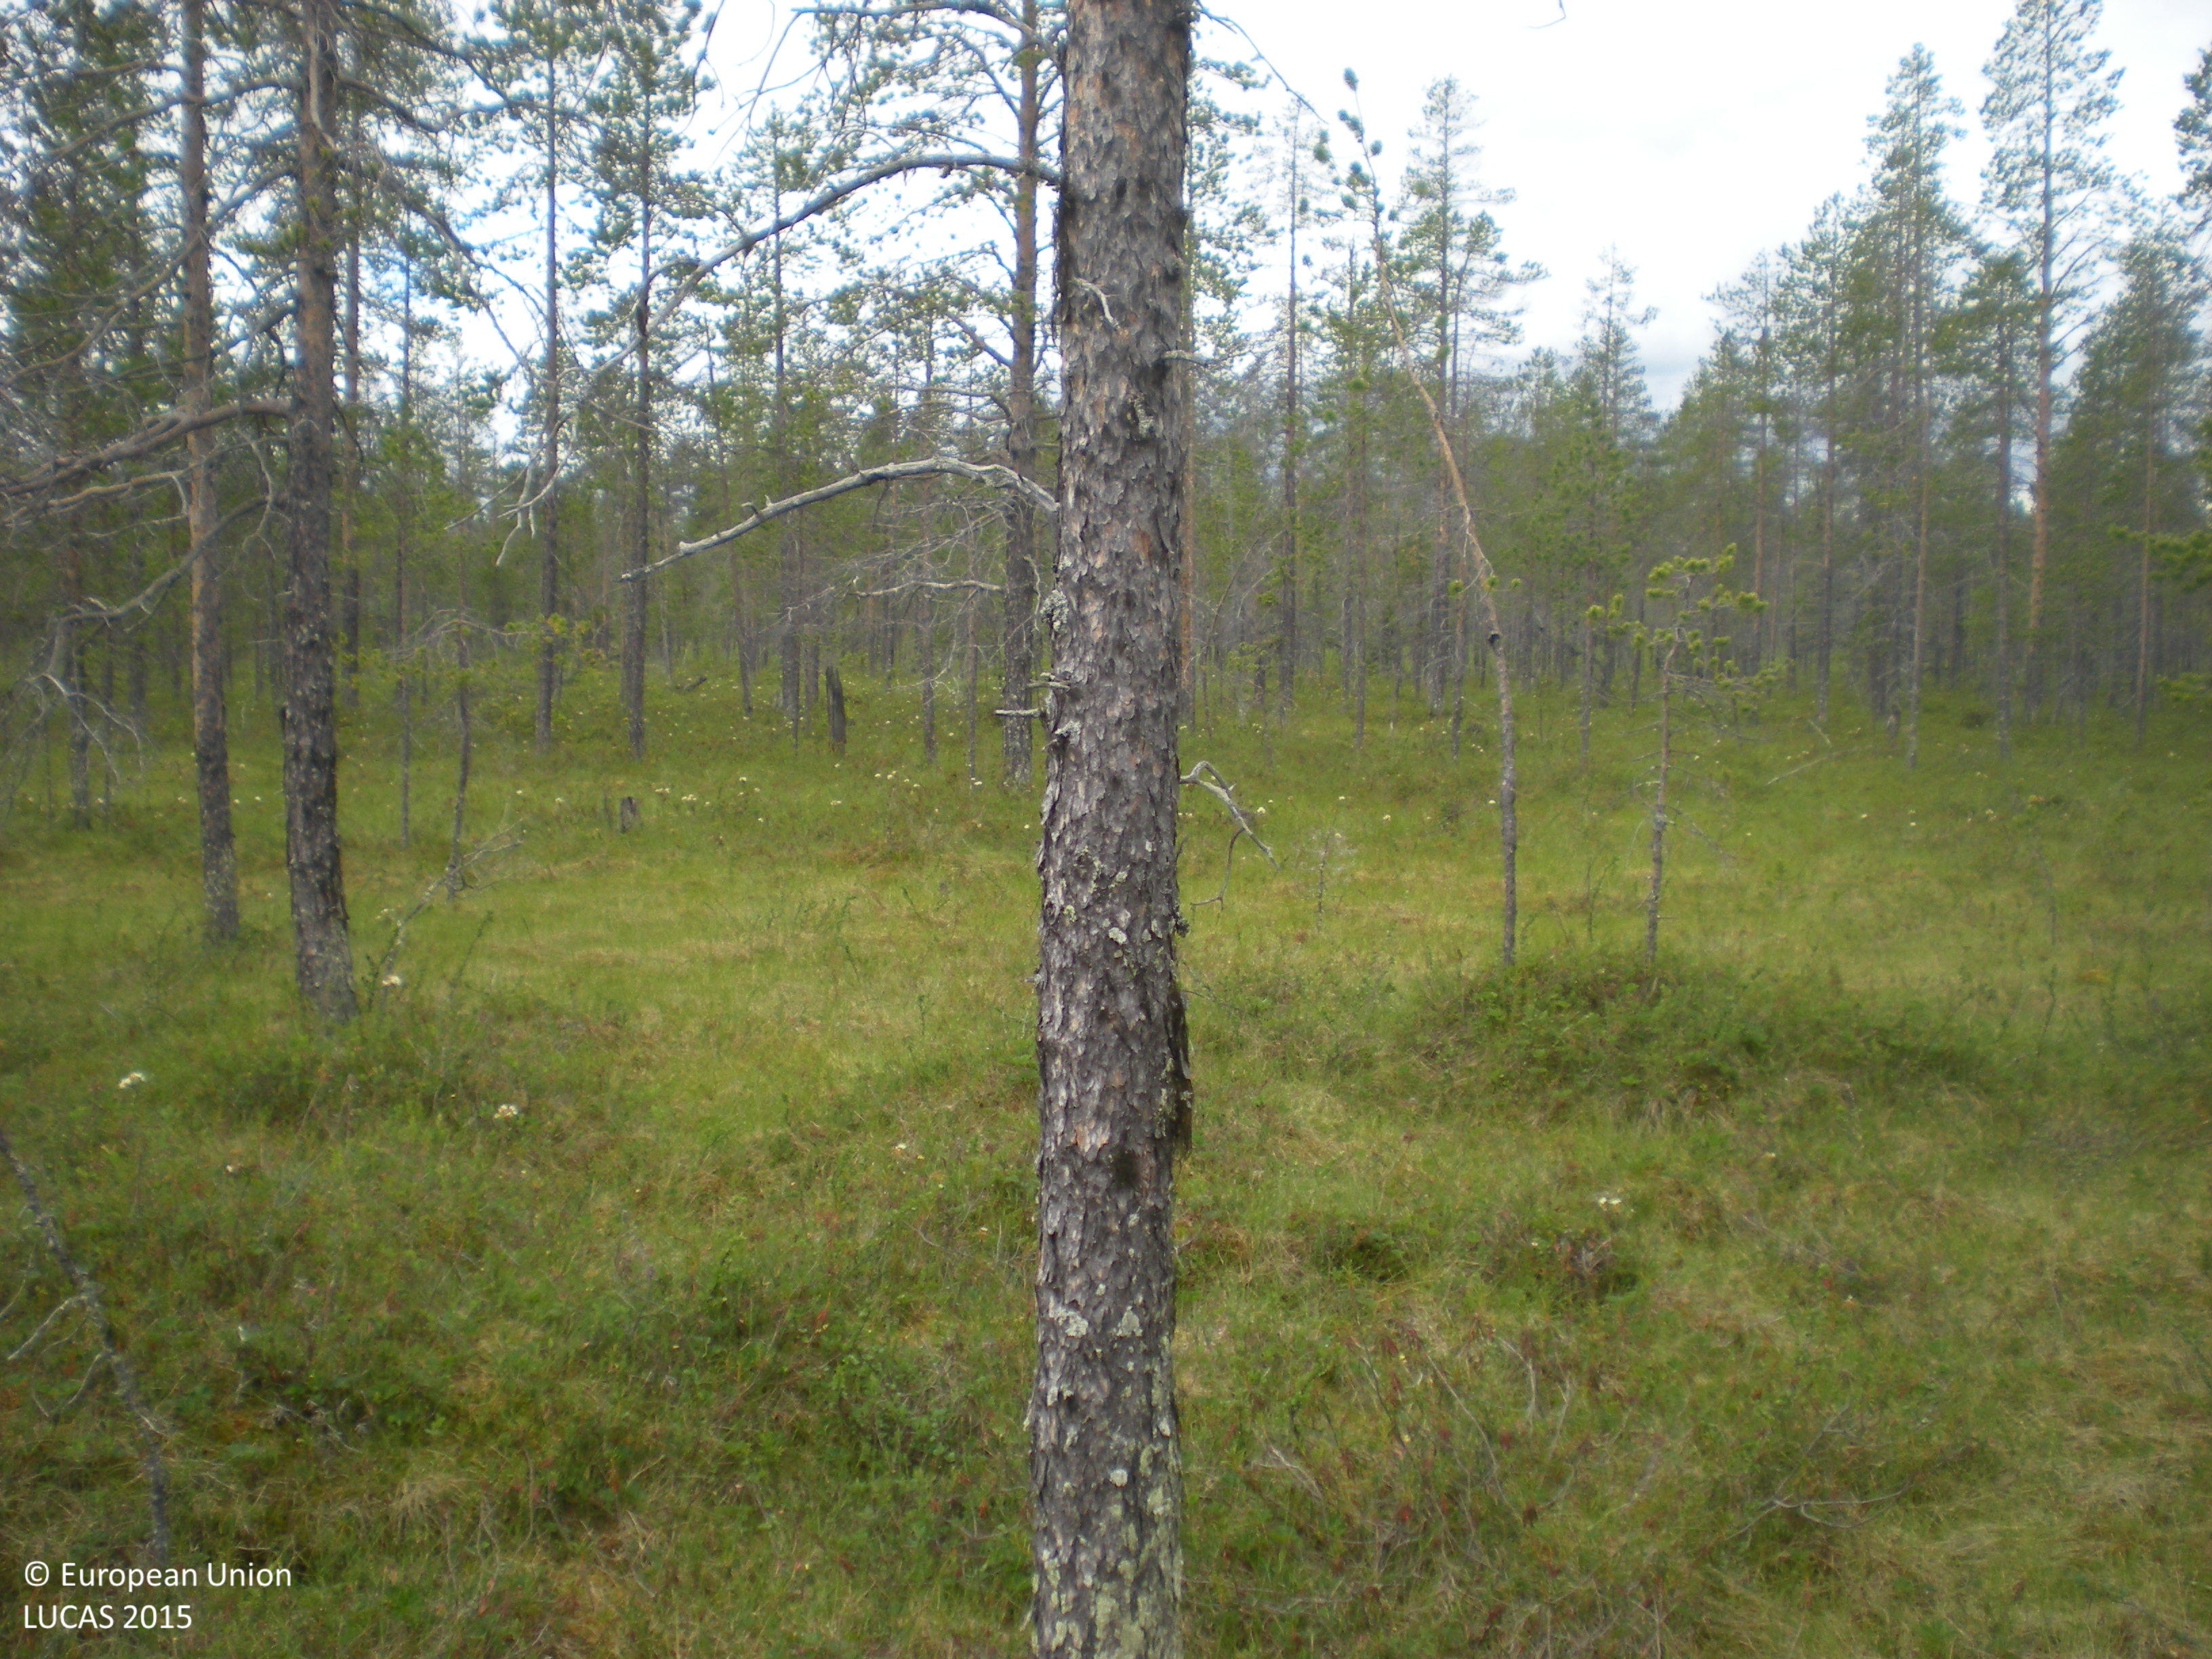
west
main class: Woodland
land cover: Pine dominated coniferous woodland
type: mire and swamp forests
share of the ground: 10 - 25 %
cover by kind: herbaceous plants 55 %, coniferous forest trees 20 %, shrubs 15 %, lichens and mosses 10 %
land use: Semi-natural and natural areas not in use
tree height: < 5 m
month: July
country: SE
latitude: 65.6429
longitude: 18.1508
